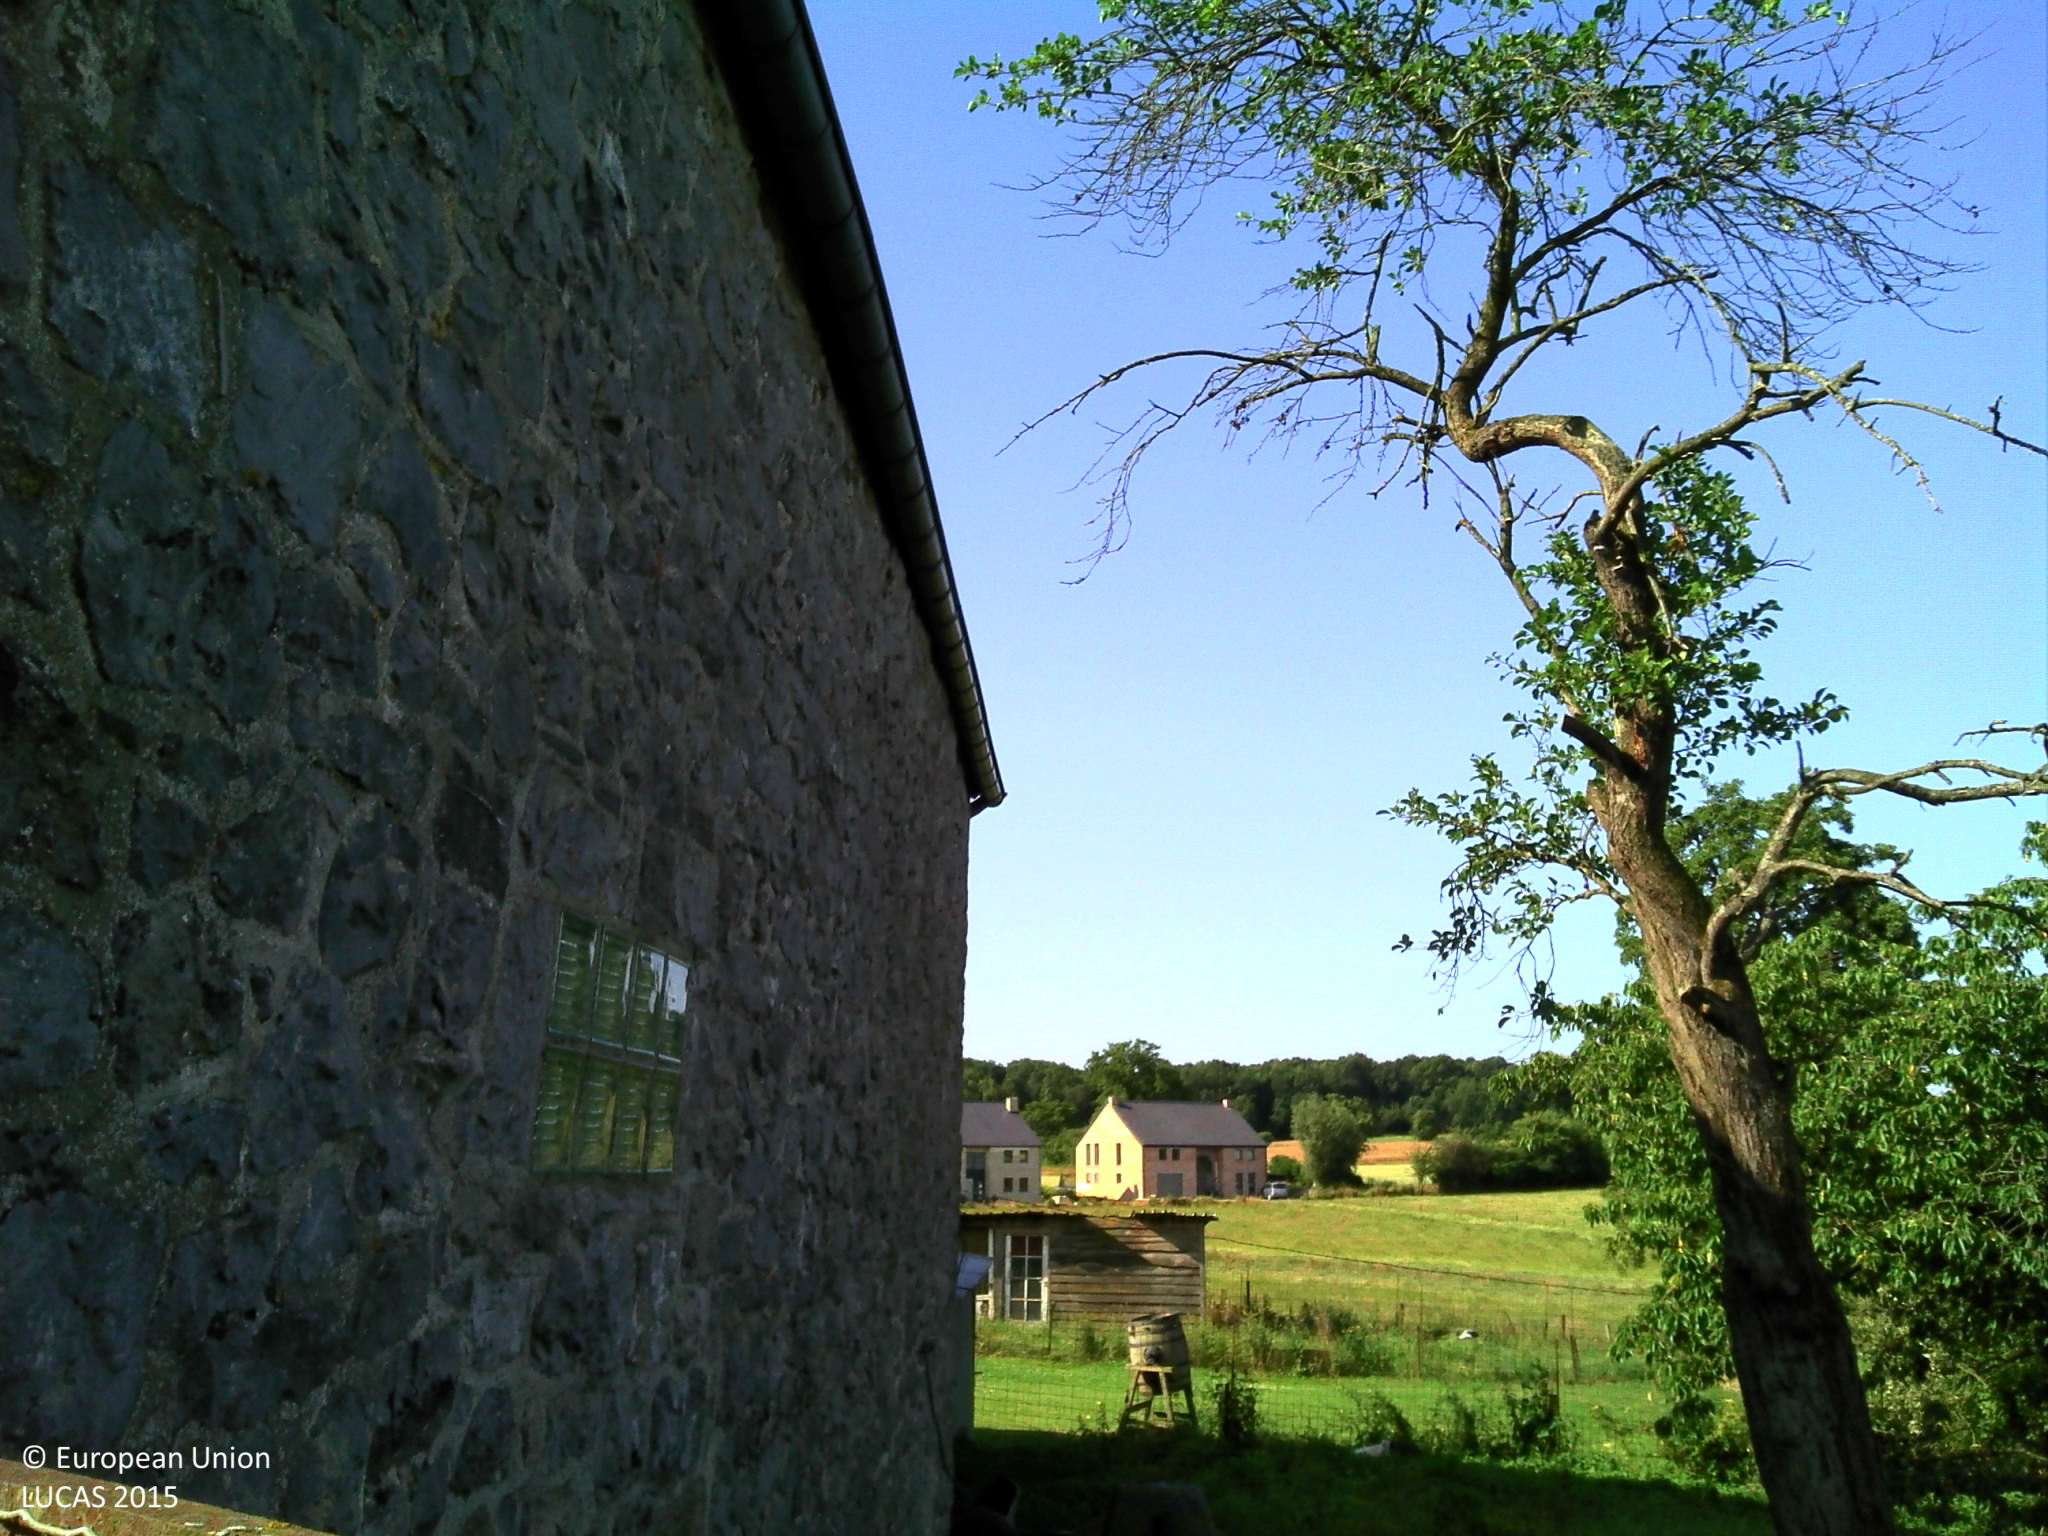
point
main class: Grassland
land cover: Grassland with sparse tree/shrub cover
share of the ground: > 75 %
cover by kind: herbaceous plants 95 %, broadleaved forest trees 5 %
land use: Residential
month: July
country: BE
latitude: 50.2916
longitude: 4.6203
